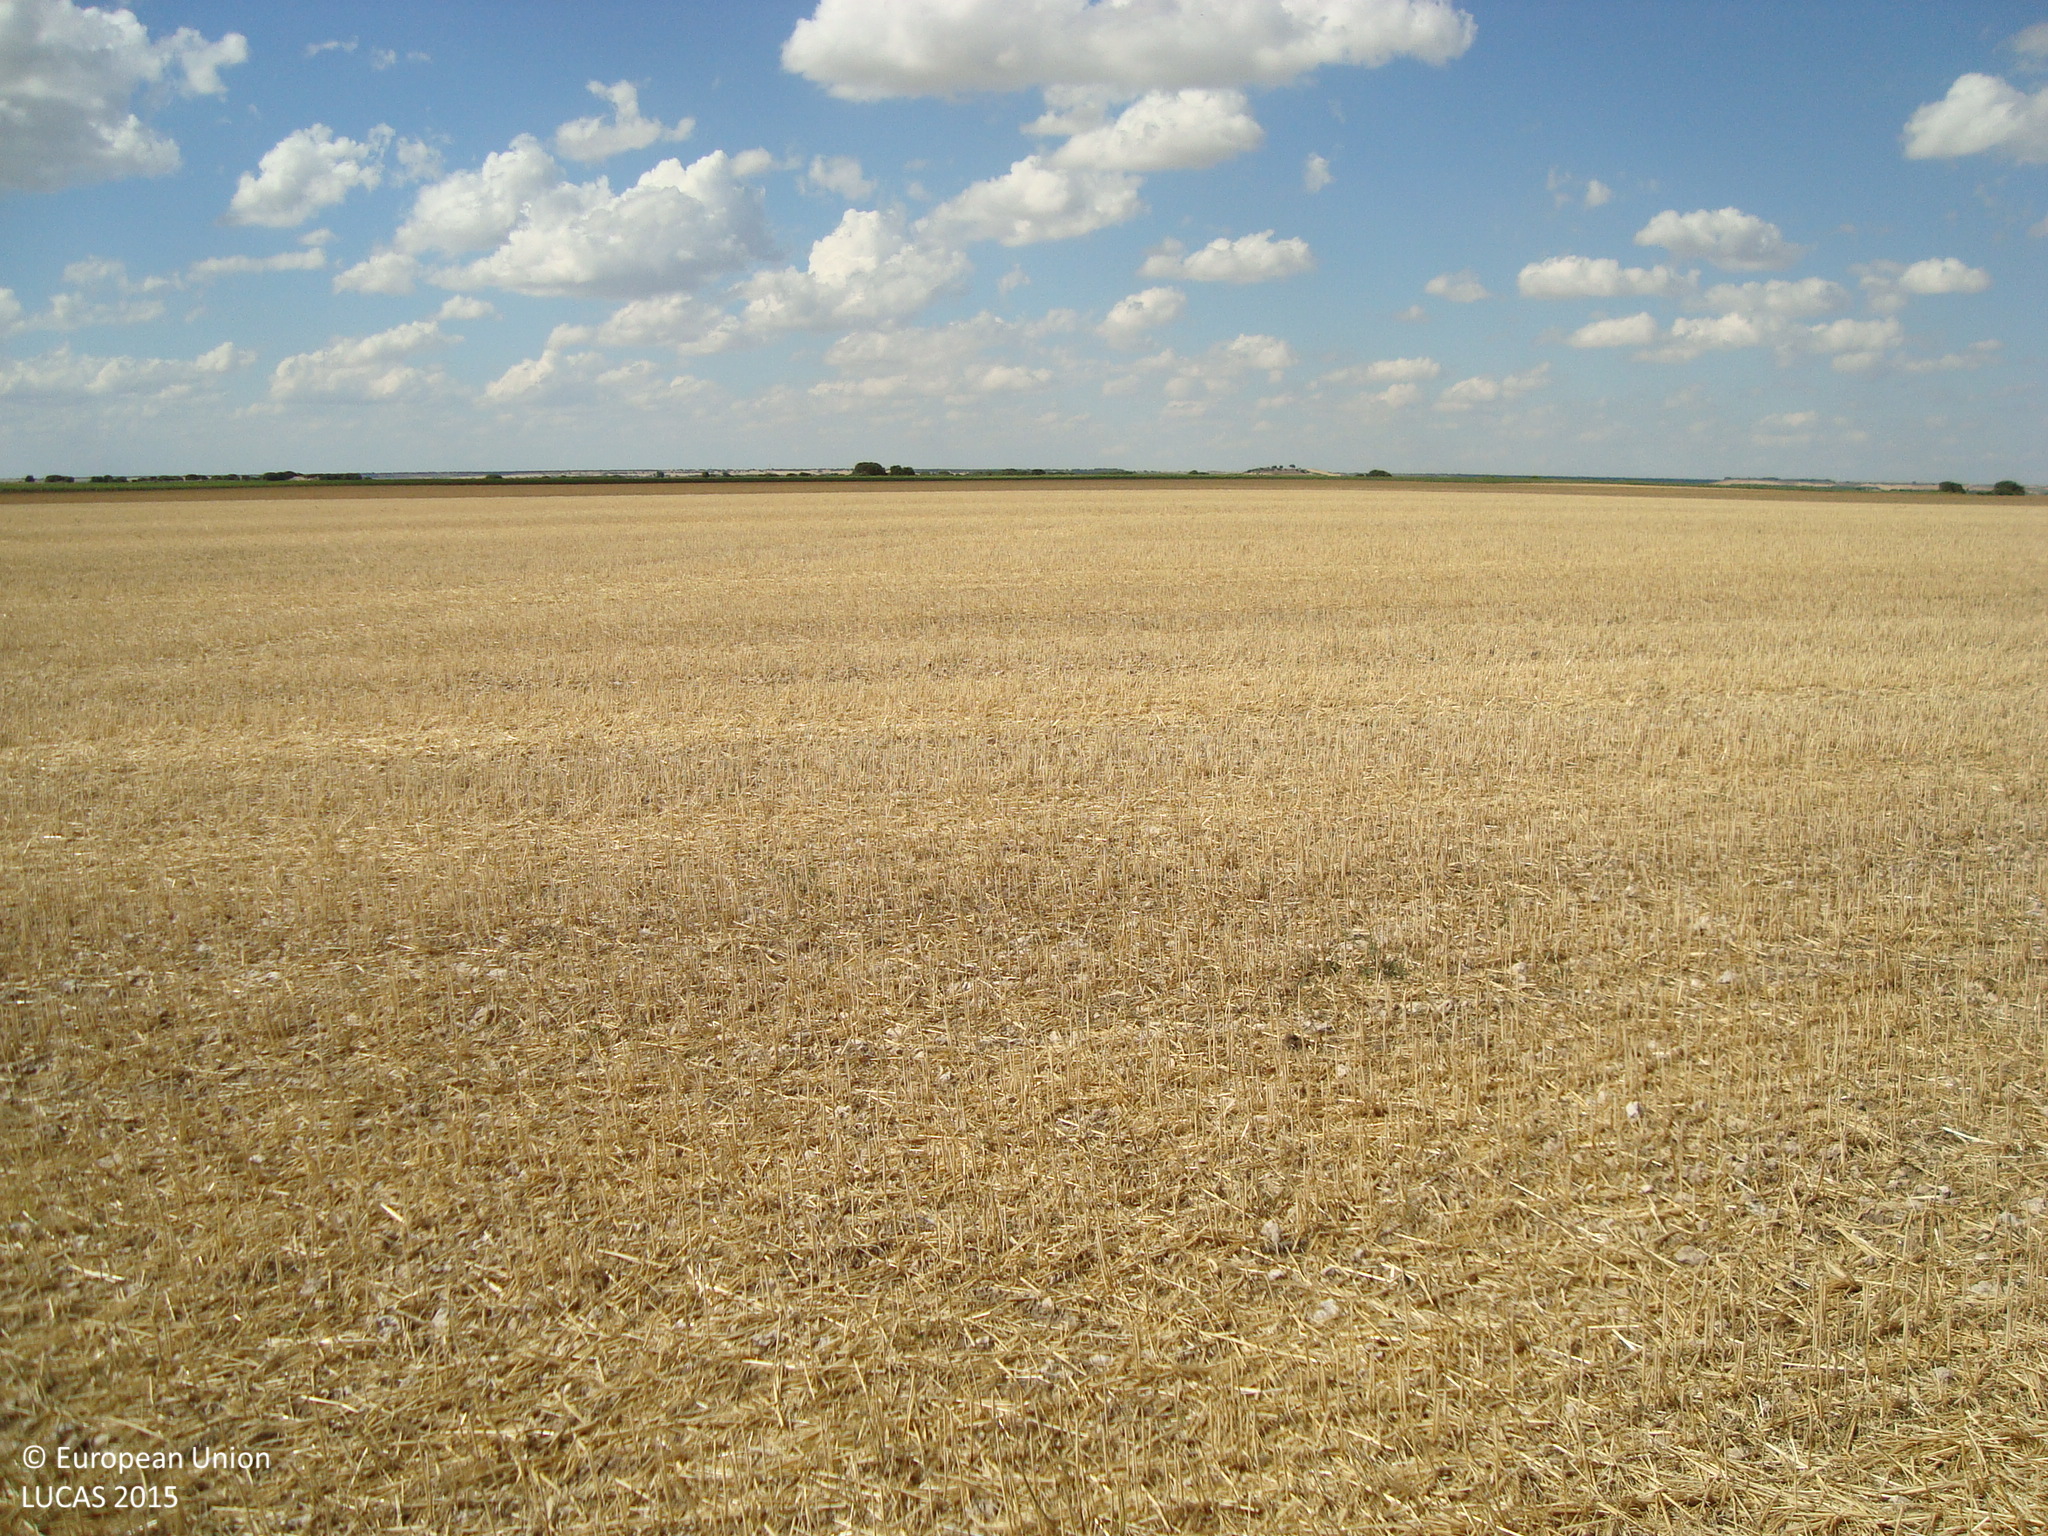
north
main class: Cropland
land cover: Barley
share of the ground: > 75 %
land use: Agriculture (excluding fallow land and kitchen gardens)
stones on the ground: < 10 %
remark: Harvested field
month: July
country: ES
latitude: 41.7189
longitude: -4.0867
